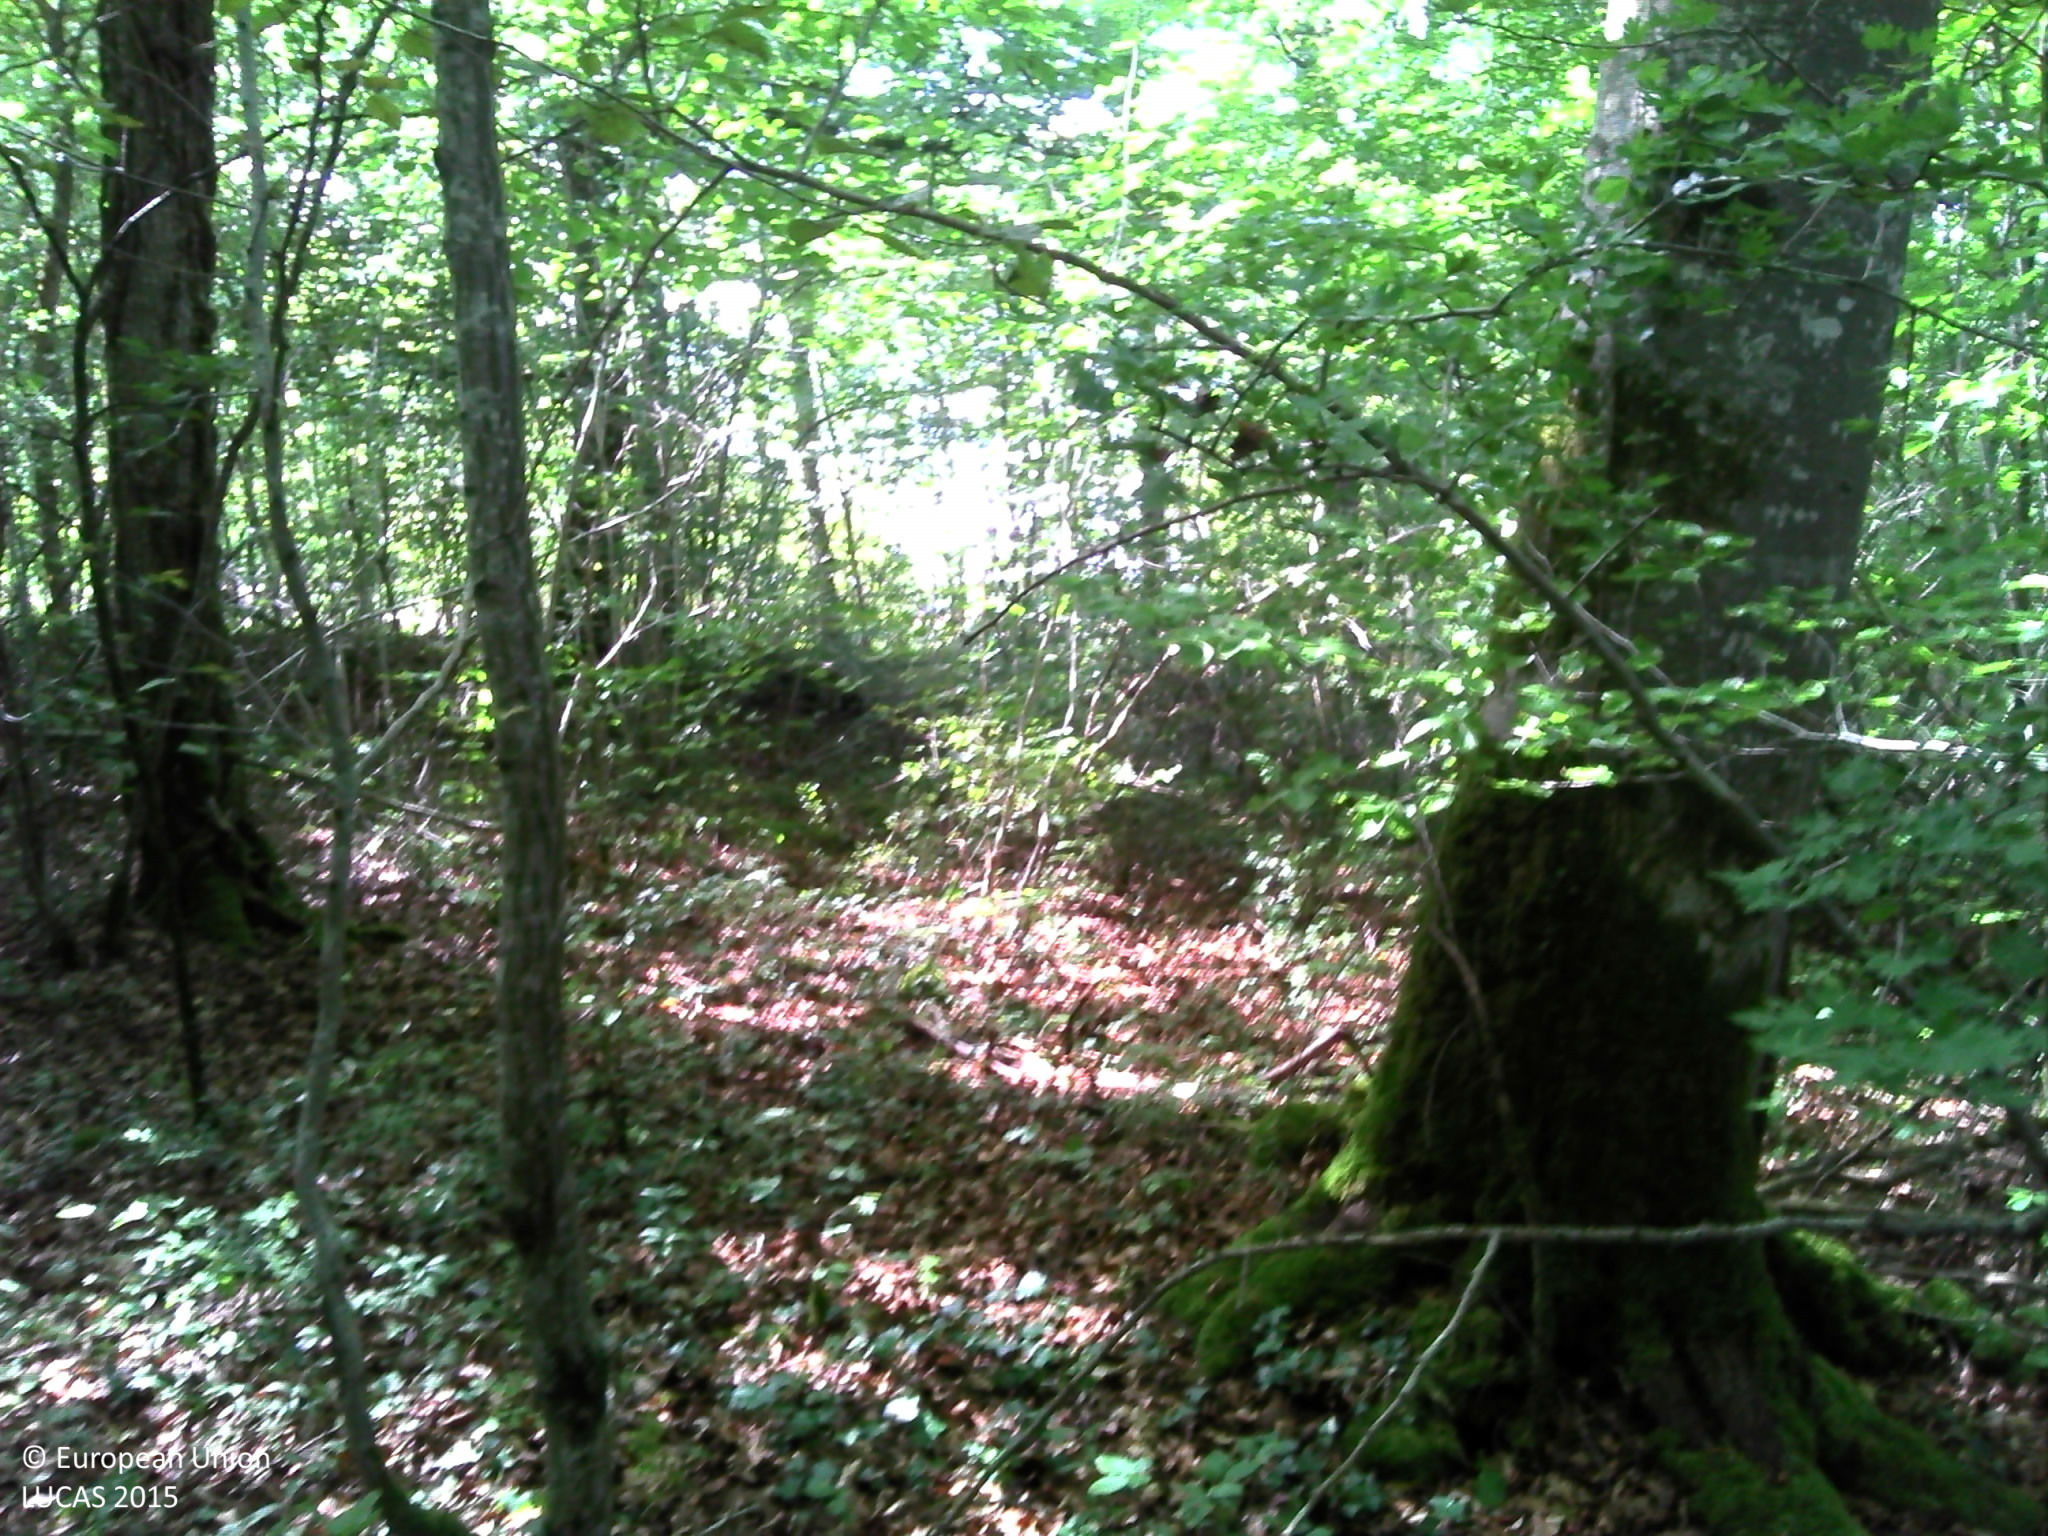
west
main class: Woodland
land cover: Broadleaved woodland
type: mesophytic deciduous forest
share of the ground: > 75 %
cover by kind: broadleaved forest trees 90 %, herbaceous plants 5 %, lichens and mosses 5 %
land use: Forestry
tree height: > 5 m
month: August
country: FR
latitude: 47.8343
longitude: 4.8824
